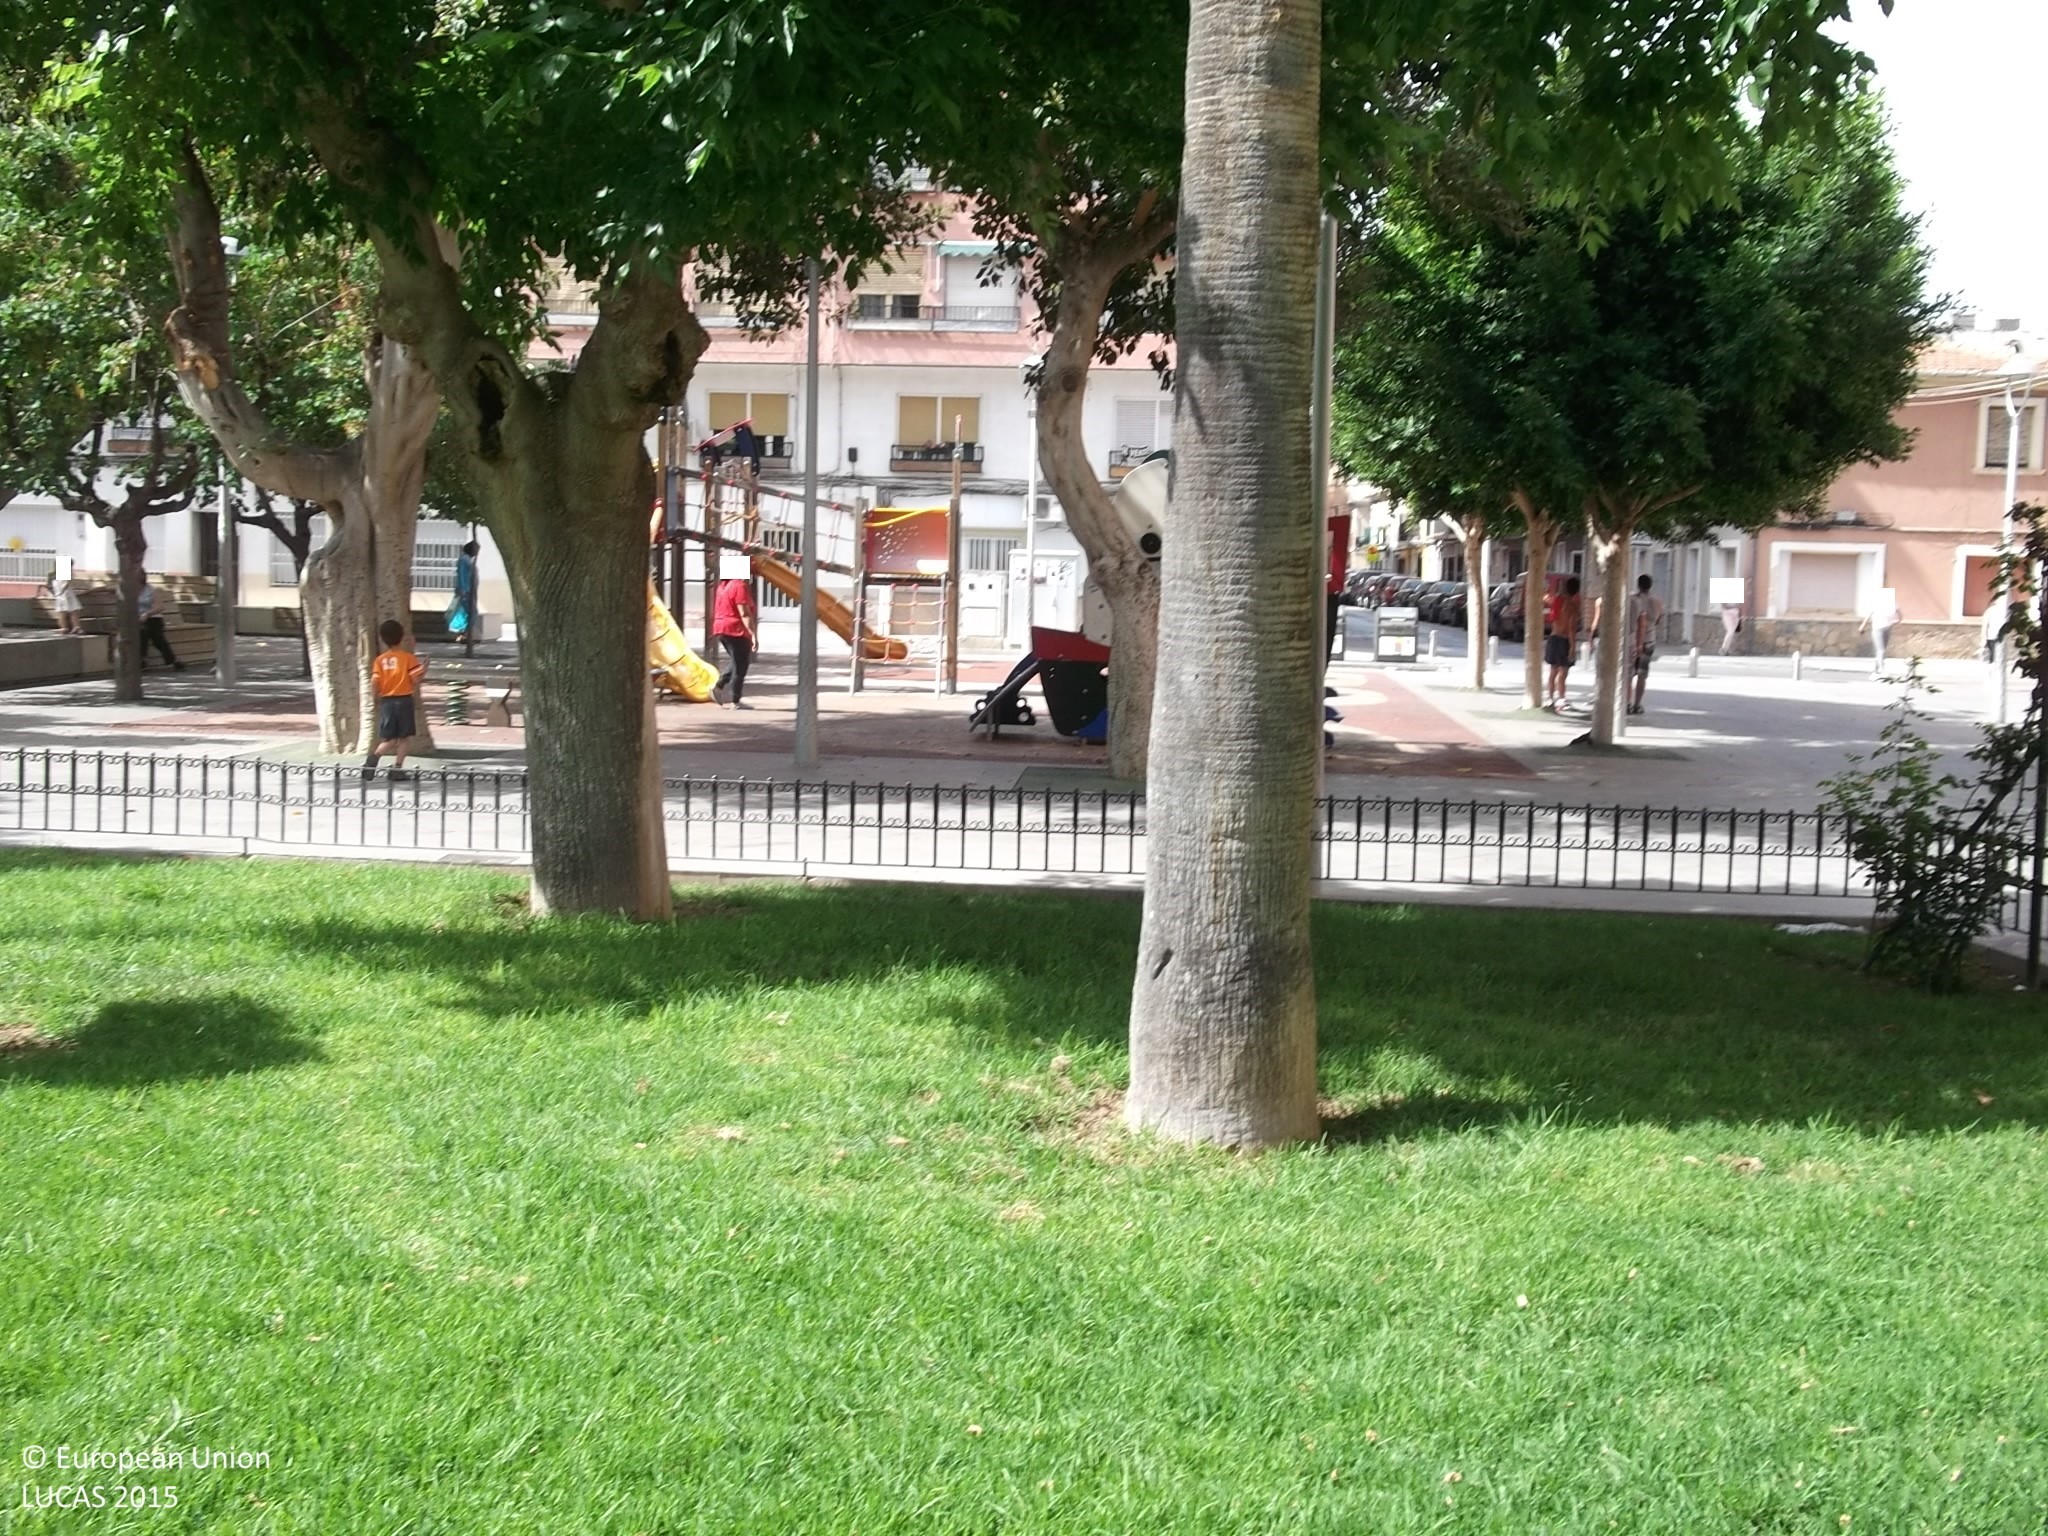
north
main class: Woodland
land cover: Broadleaved woodland
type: broadleaved evergreen forest
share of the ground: 50 - 75 %
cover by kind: broadleaved forest trees 50 %
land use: Amenities, museums, leisure
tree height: > 5 m
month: May
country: ES
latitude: 38.1269
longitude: -0.8788
